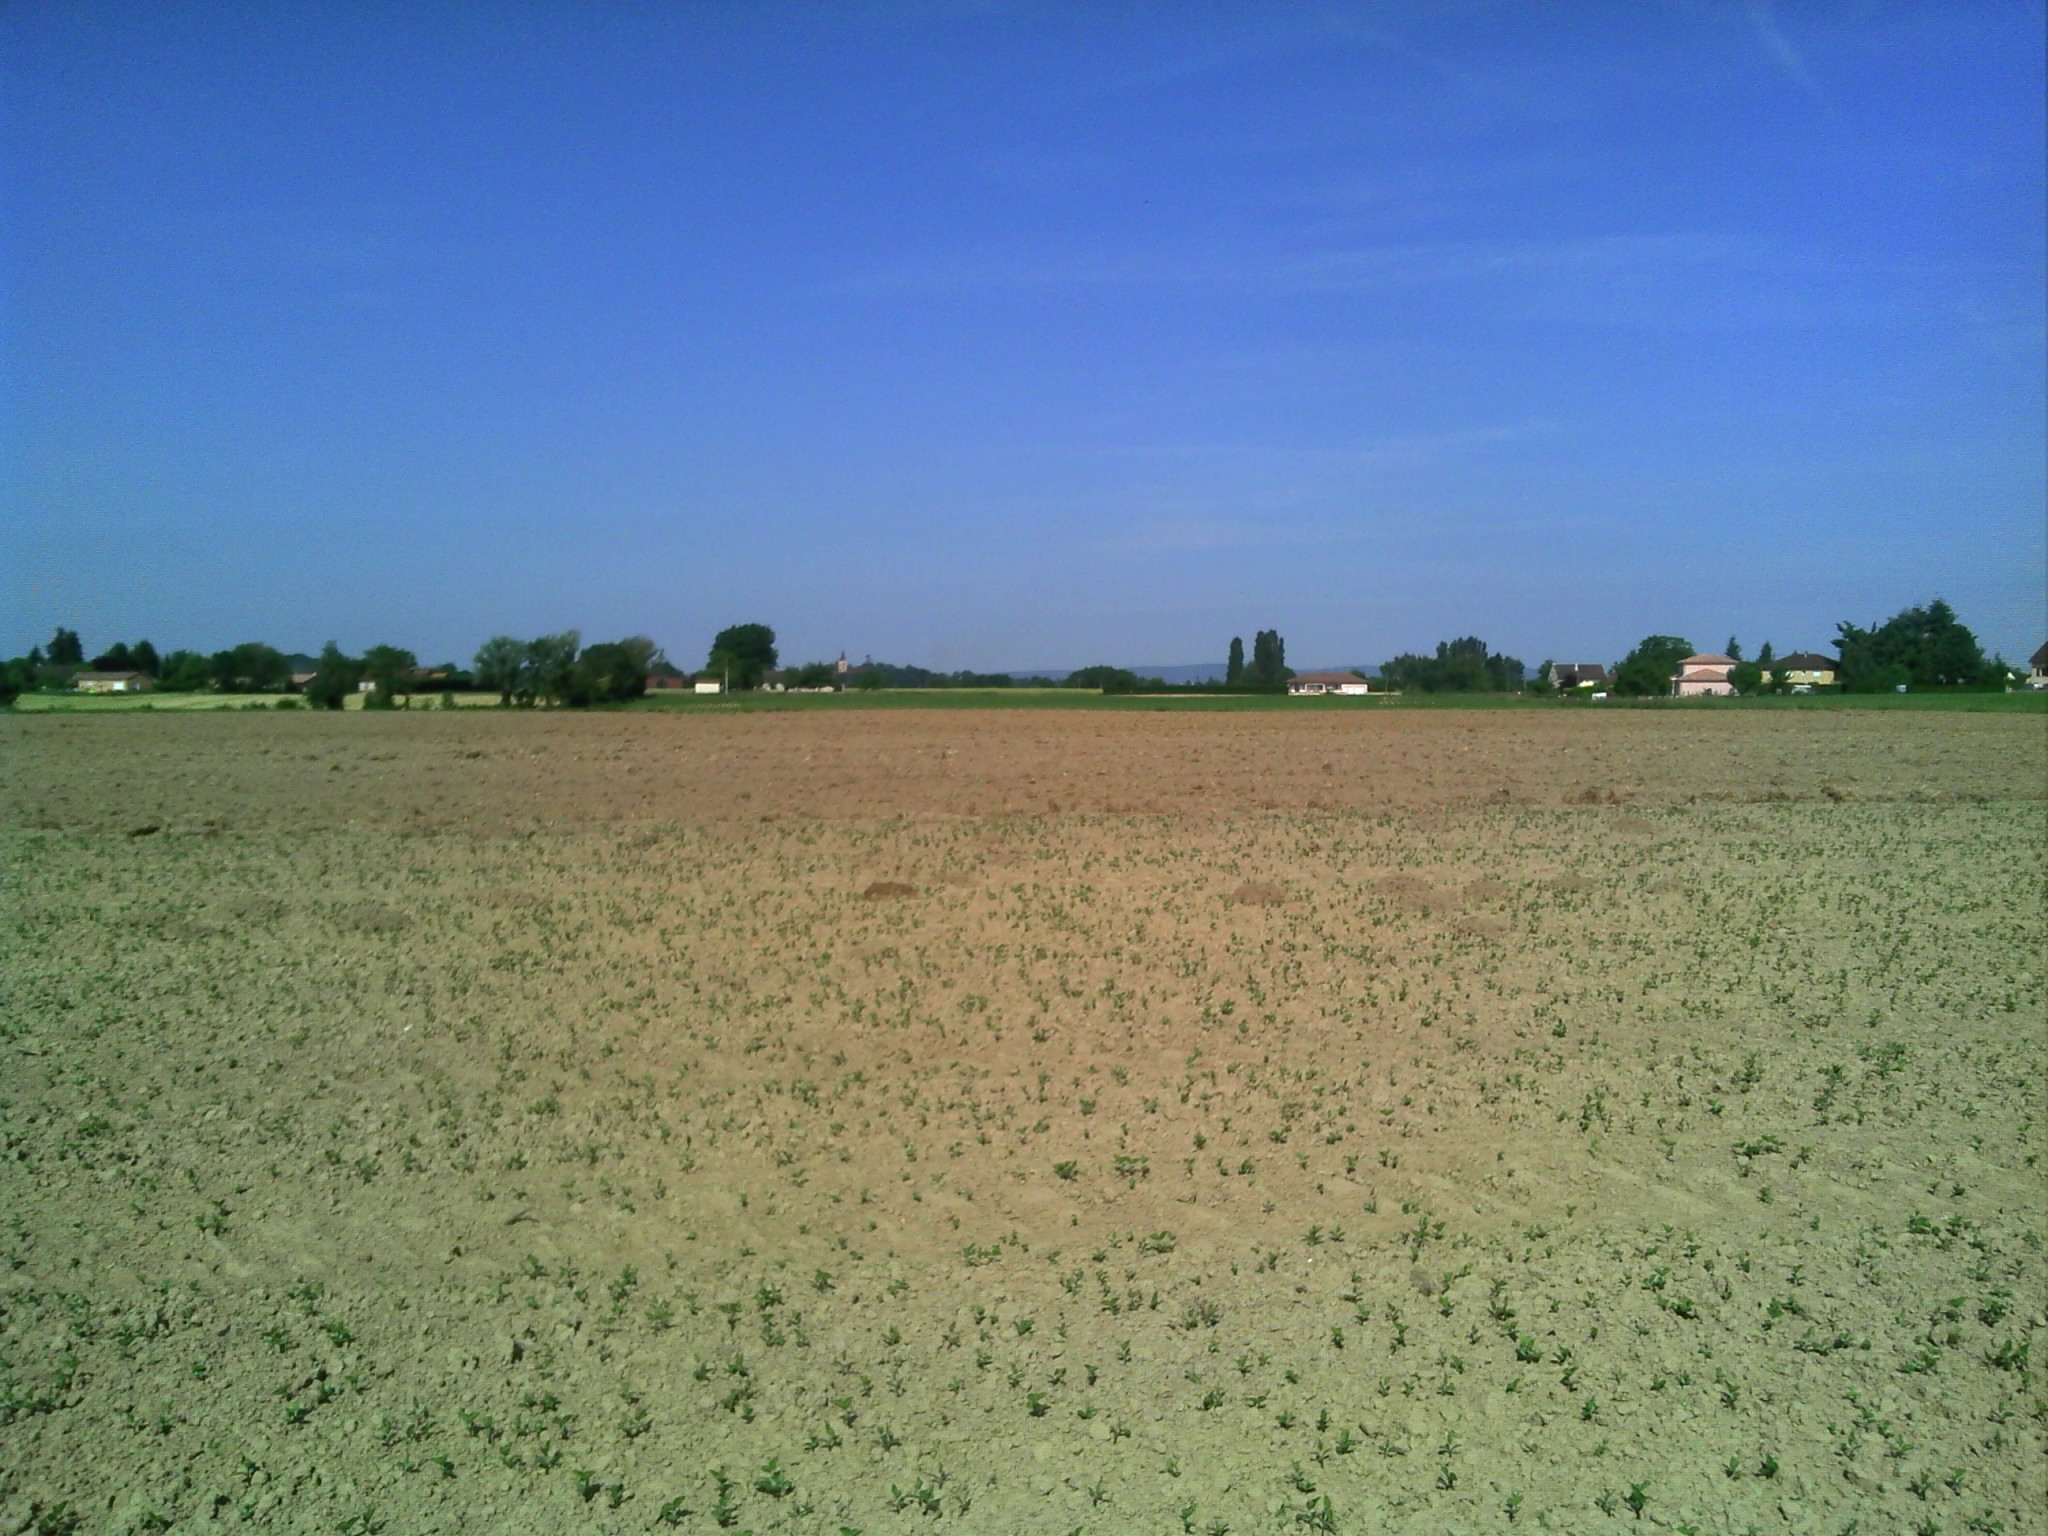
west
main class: Cropland
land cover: Soya
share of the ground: < 10 %
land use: Agriculture (excluding fallow land and kitchen gardens)
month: May
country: FR
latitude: 46.5606
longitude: 5.0320
